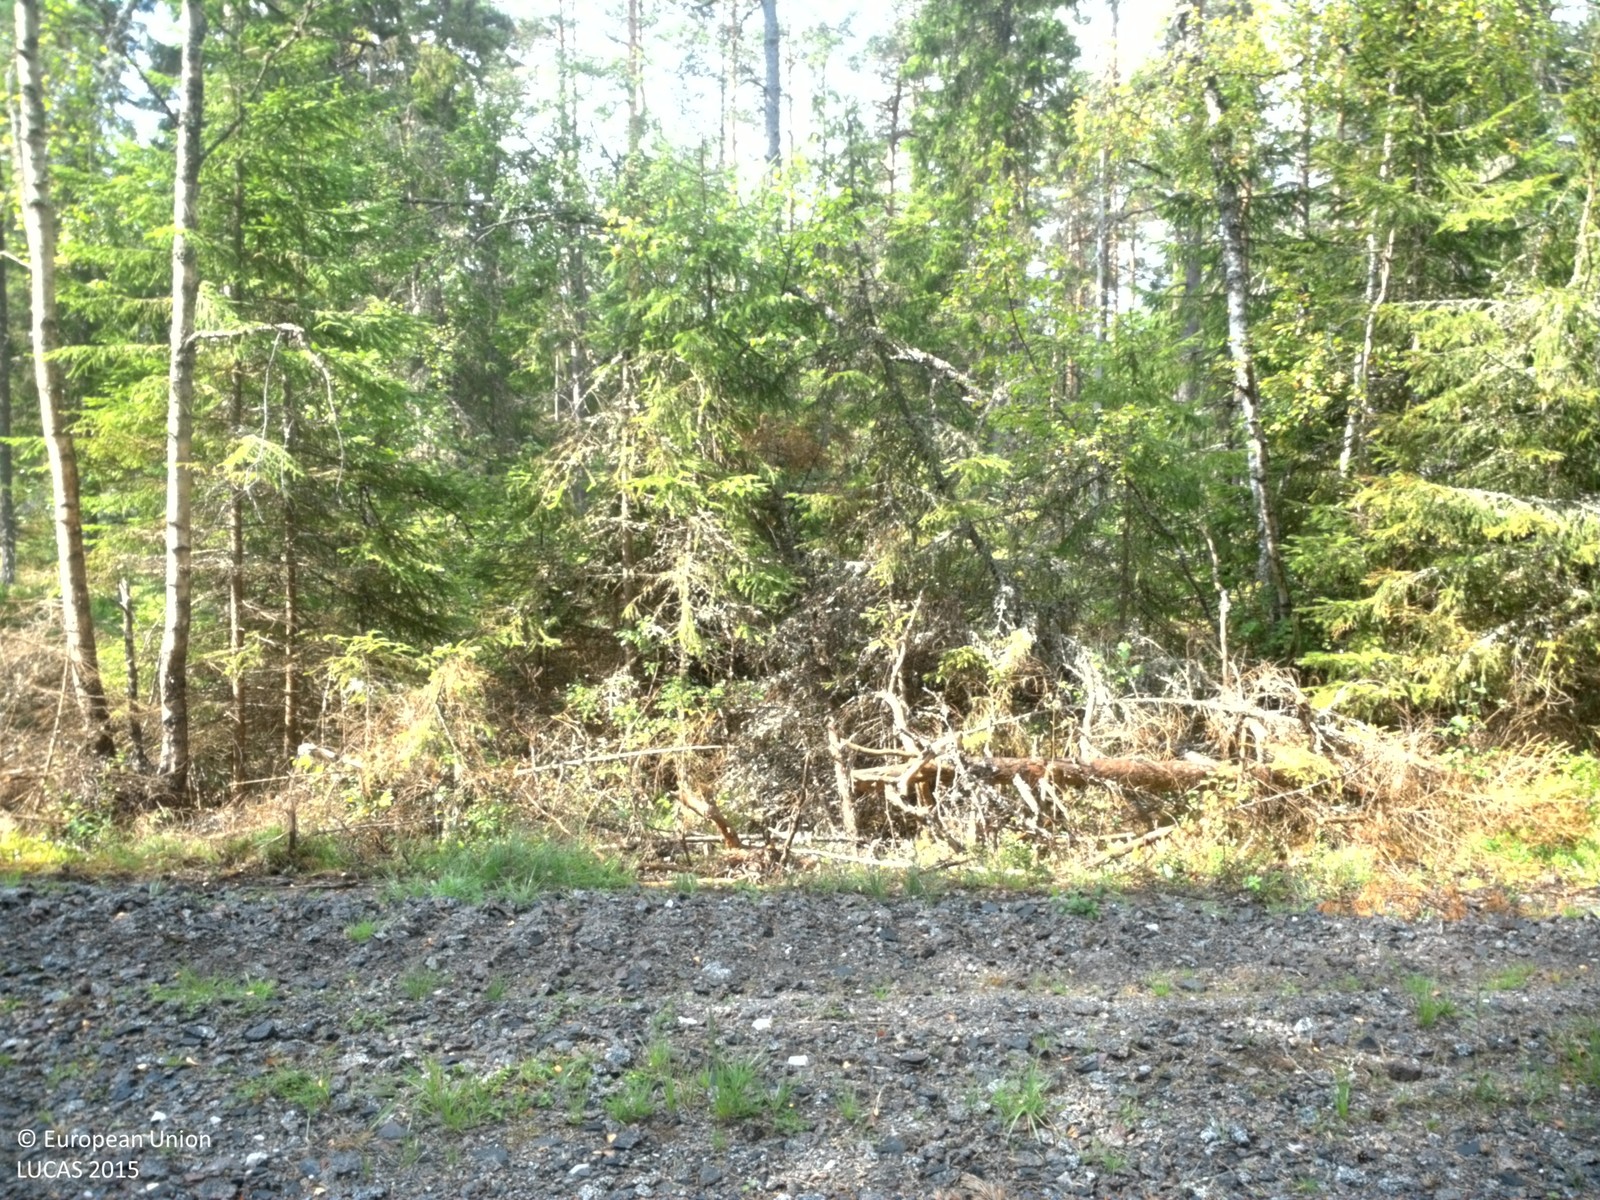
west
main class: Woodland
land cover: Pine dominated coniferous woodland
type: boreal forest
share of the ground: 25 - 50 %
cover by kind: shrubs 60 %, coniferous forest trees 40 %
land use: Forestry
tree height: > 5 m
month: August
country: SE
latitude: 57.9809
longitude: 13.9685
